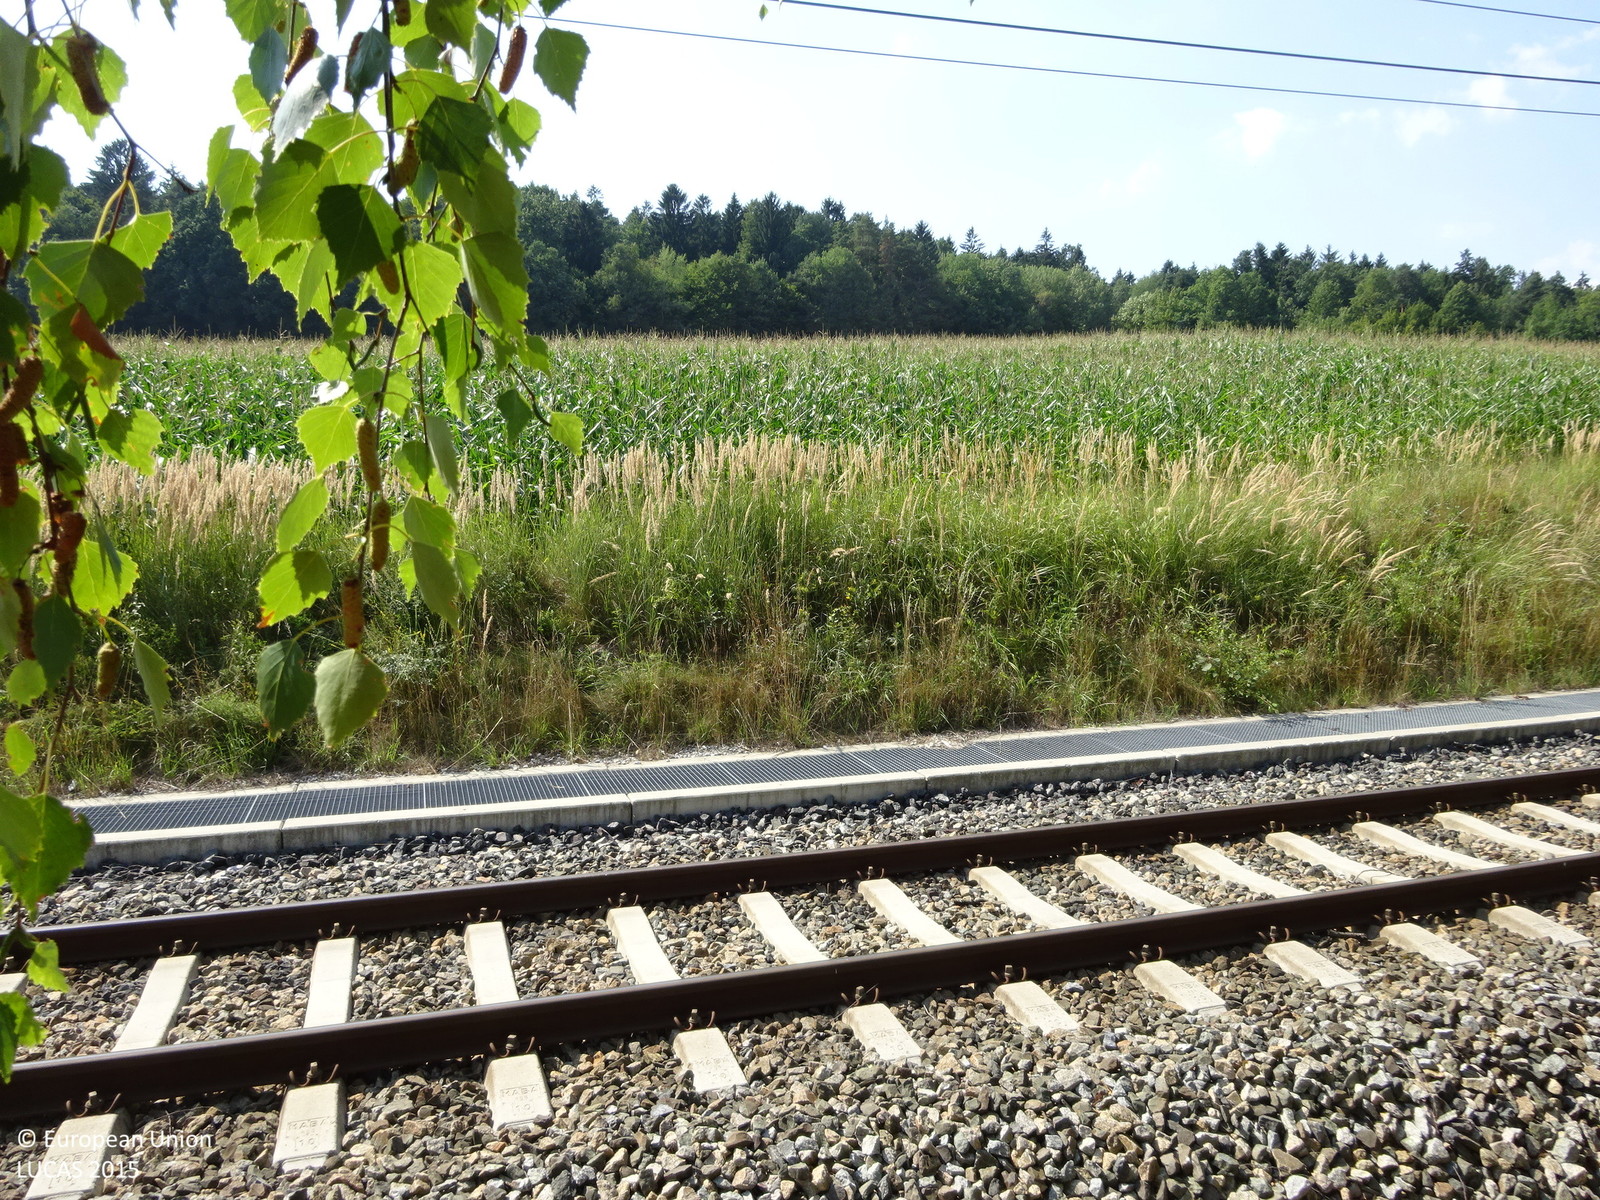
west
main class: Woodland
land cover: Broadleaved woodland
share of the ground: 10 - 25 %
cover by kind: unconsolidated bare surface 45 %, broadleaved forest trees 25 %, herbaceous plants 20 %, consolidated bare surface 10 %
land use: Forestry
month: August
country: AT
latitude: 47.4102
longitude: 16.0055
